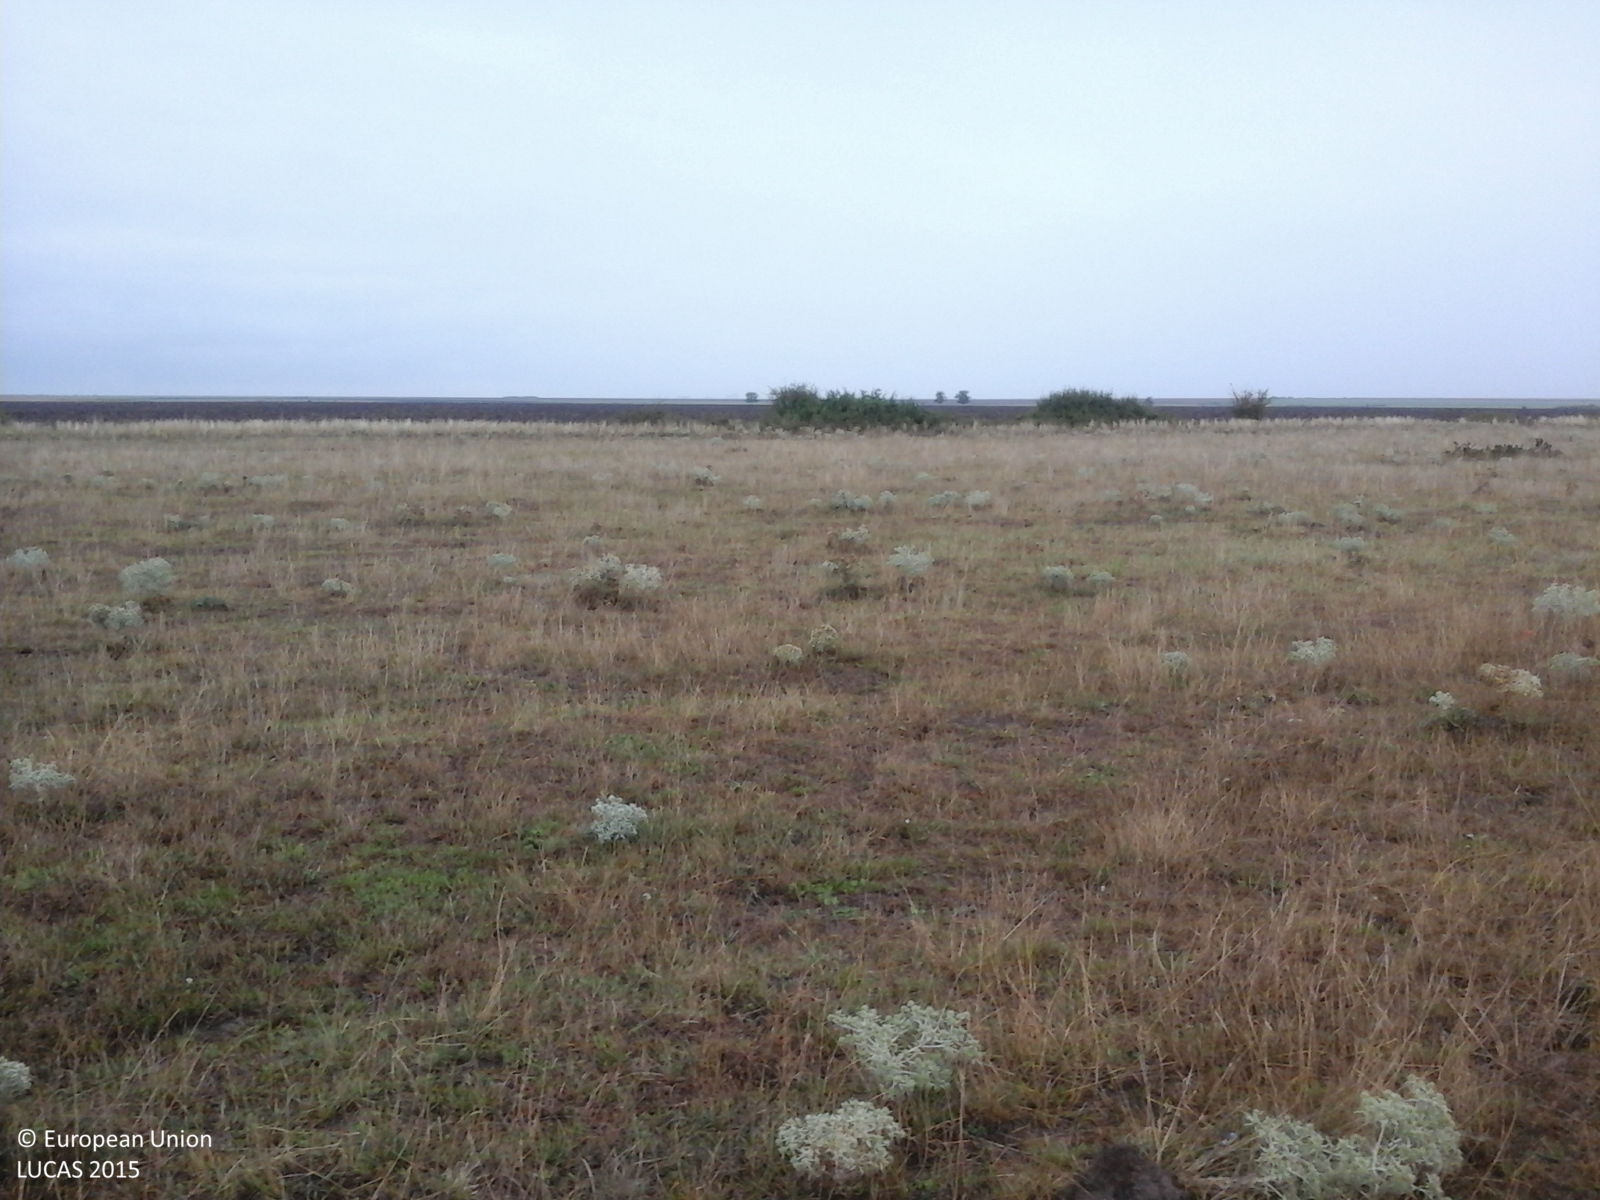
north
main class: Grassland
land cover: Spontaneously vegetated surfaces
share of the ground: > 75 %
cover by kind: herbaceous plants 100 %
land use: Fallow land
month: August
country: RO
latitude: 45.4639
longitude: 21.4266
